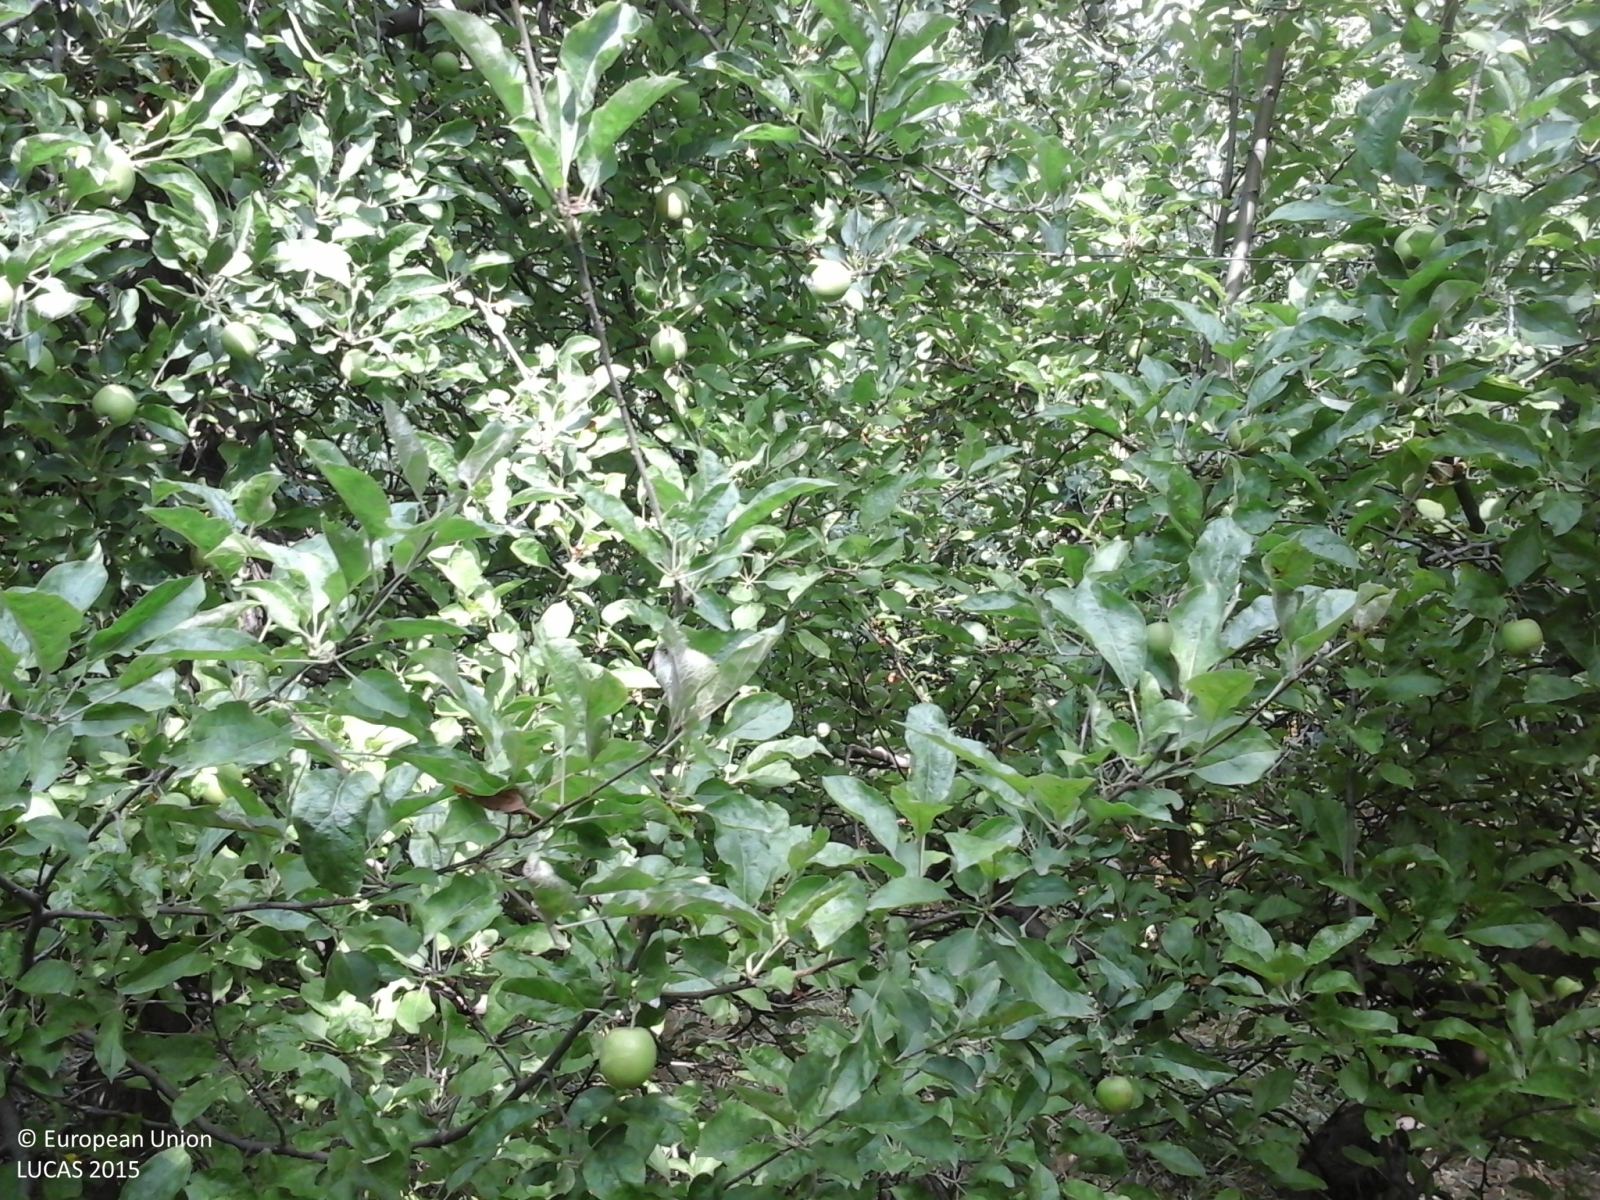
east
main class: Cropland
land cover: Apple fruit
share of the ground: 50 - 75 %
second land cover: Grassland without tree/shrub cover
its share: > 75 %
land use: Agriculture (excluding fallow land and kitchen gardens)
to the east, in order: Apple fruit; Grassland without tree/shrub cover; Artificial constructions in urban areas; Maize; Grass margins; Artificial constructions in urban areas
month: June
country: IT
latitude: 45.3349
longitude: 11.2356
